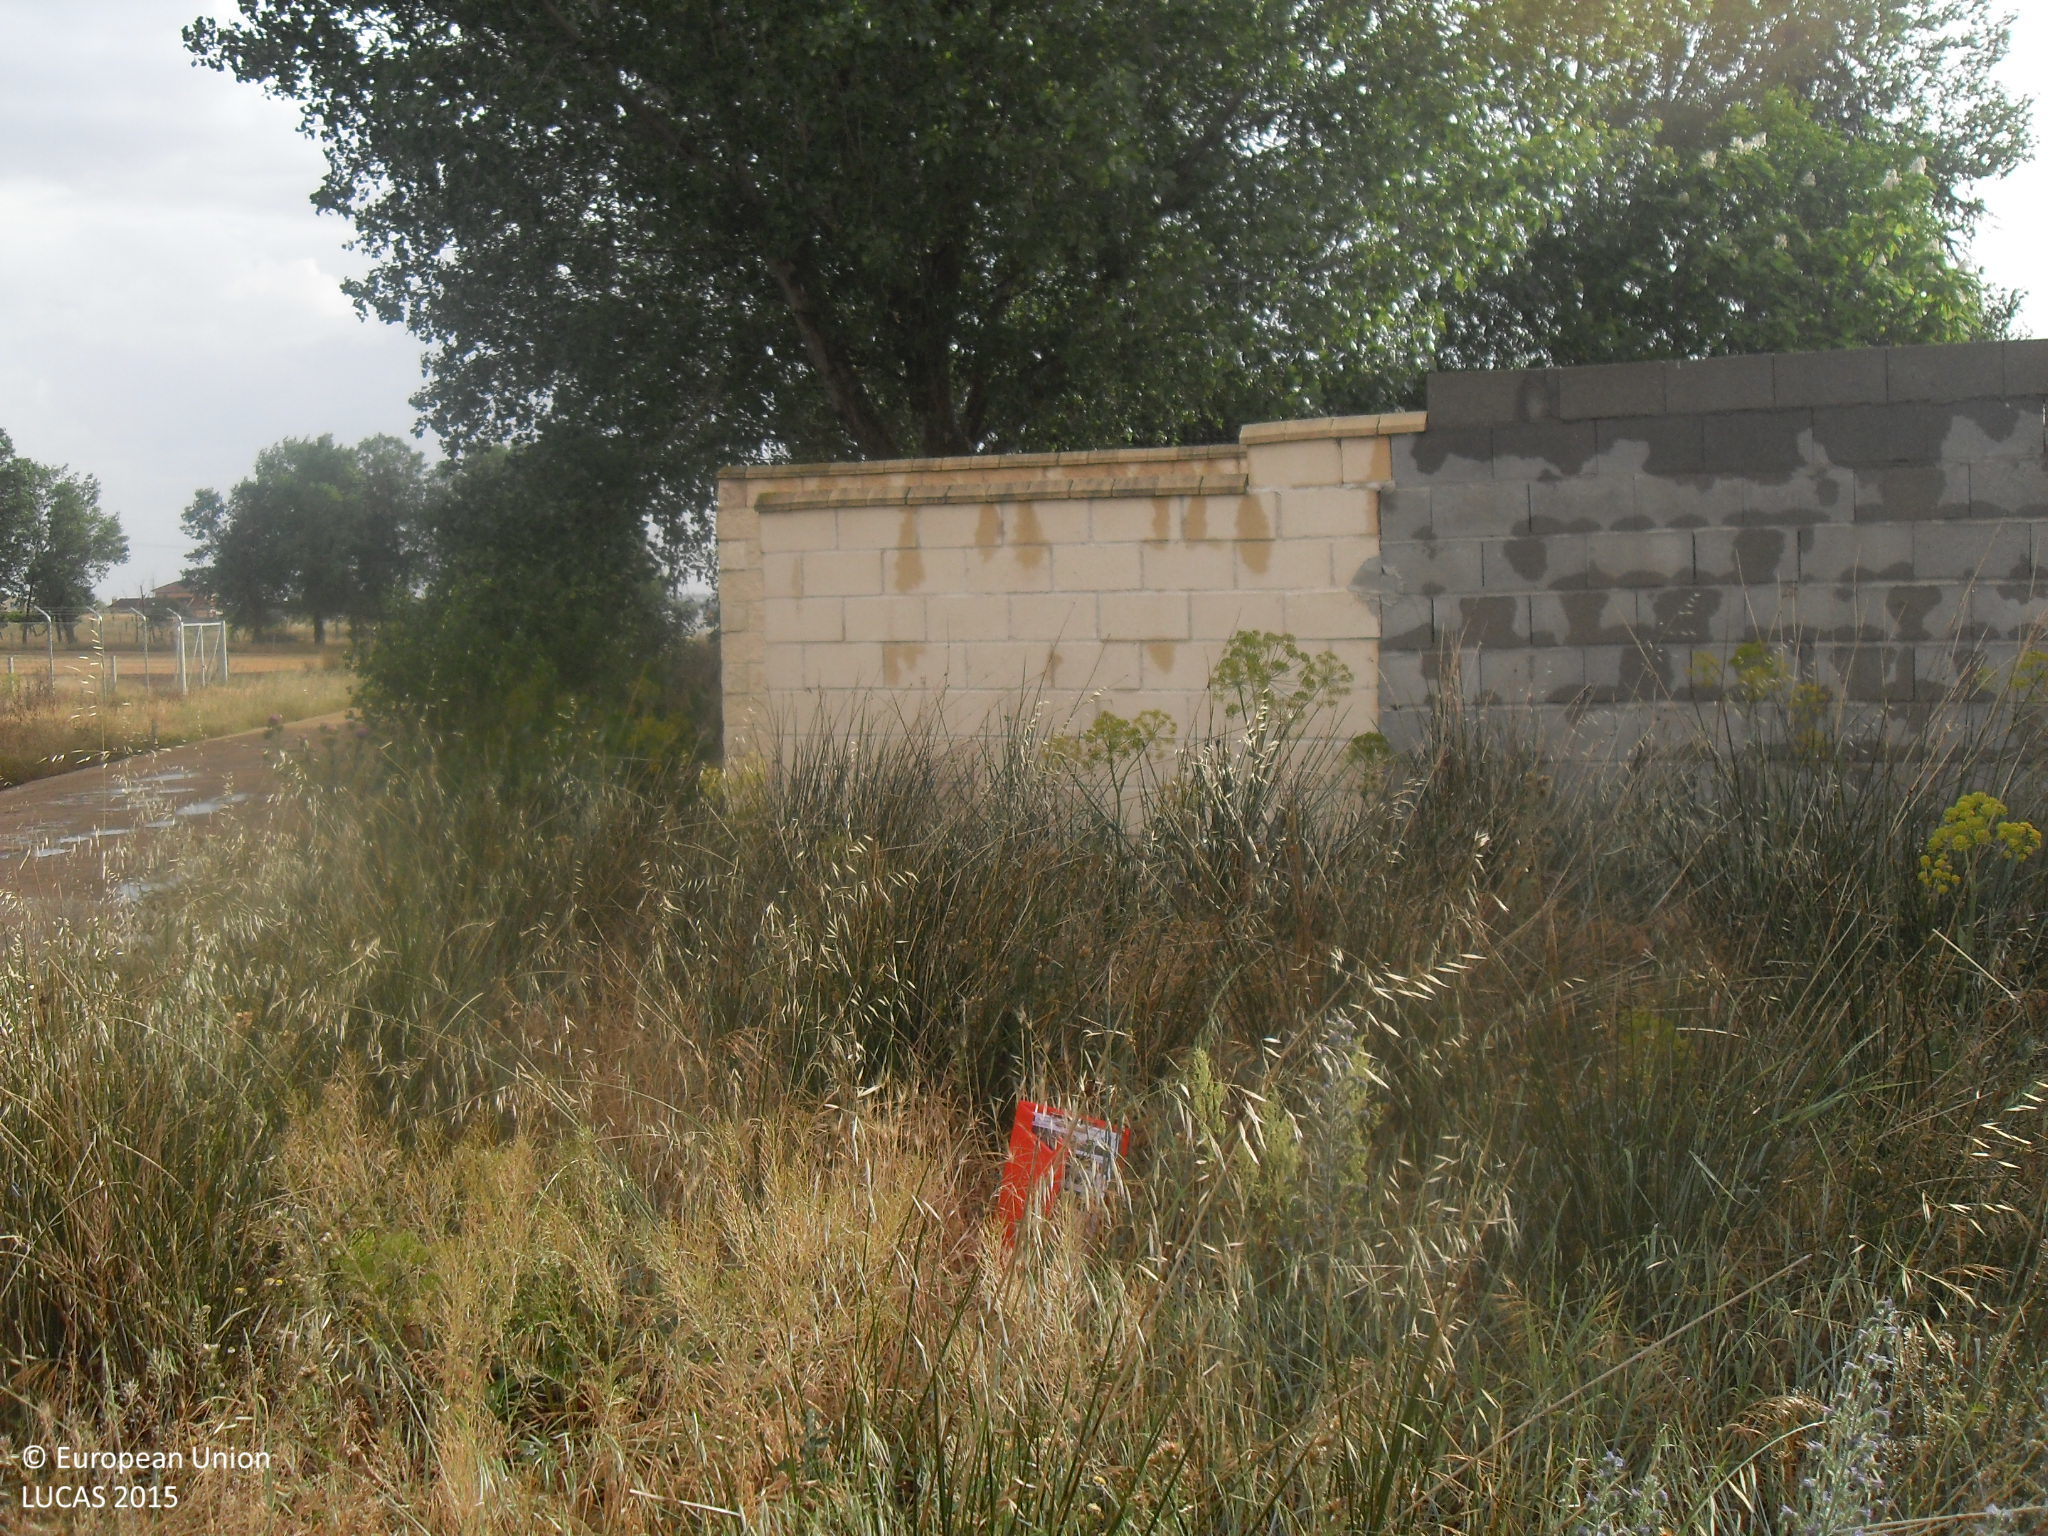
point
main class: Grassland
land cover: Spontaneously vegetated surfaces
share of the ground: > 75 %
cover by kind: herbaceous plants 100 %
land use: Abandoned areas
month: June
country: ES
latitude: 41.0179
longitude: -5.6924
